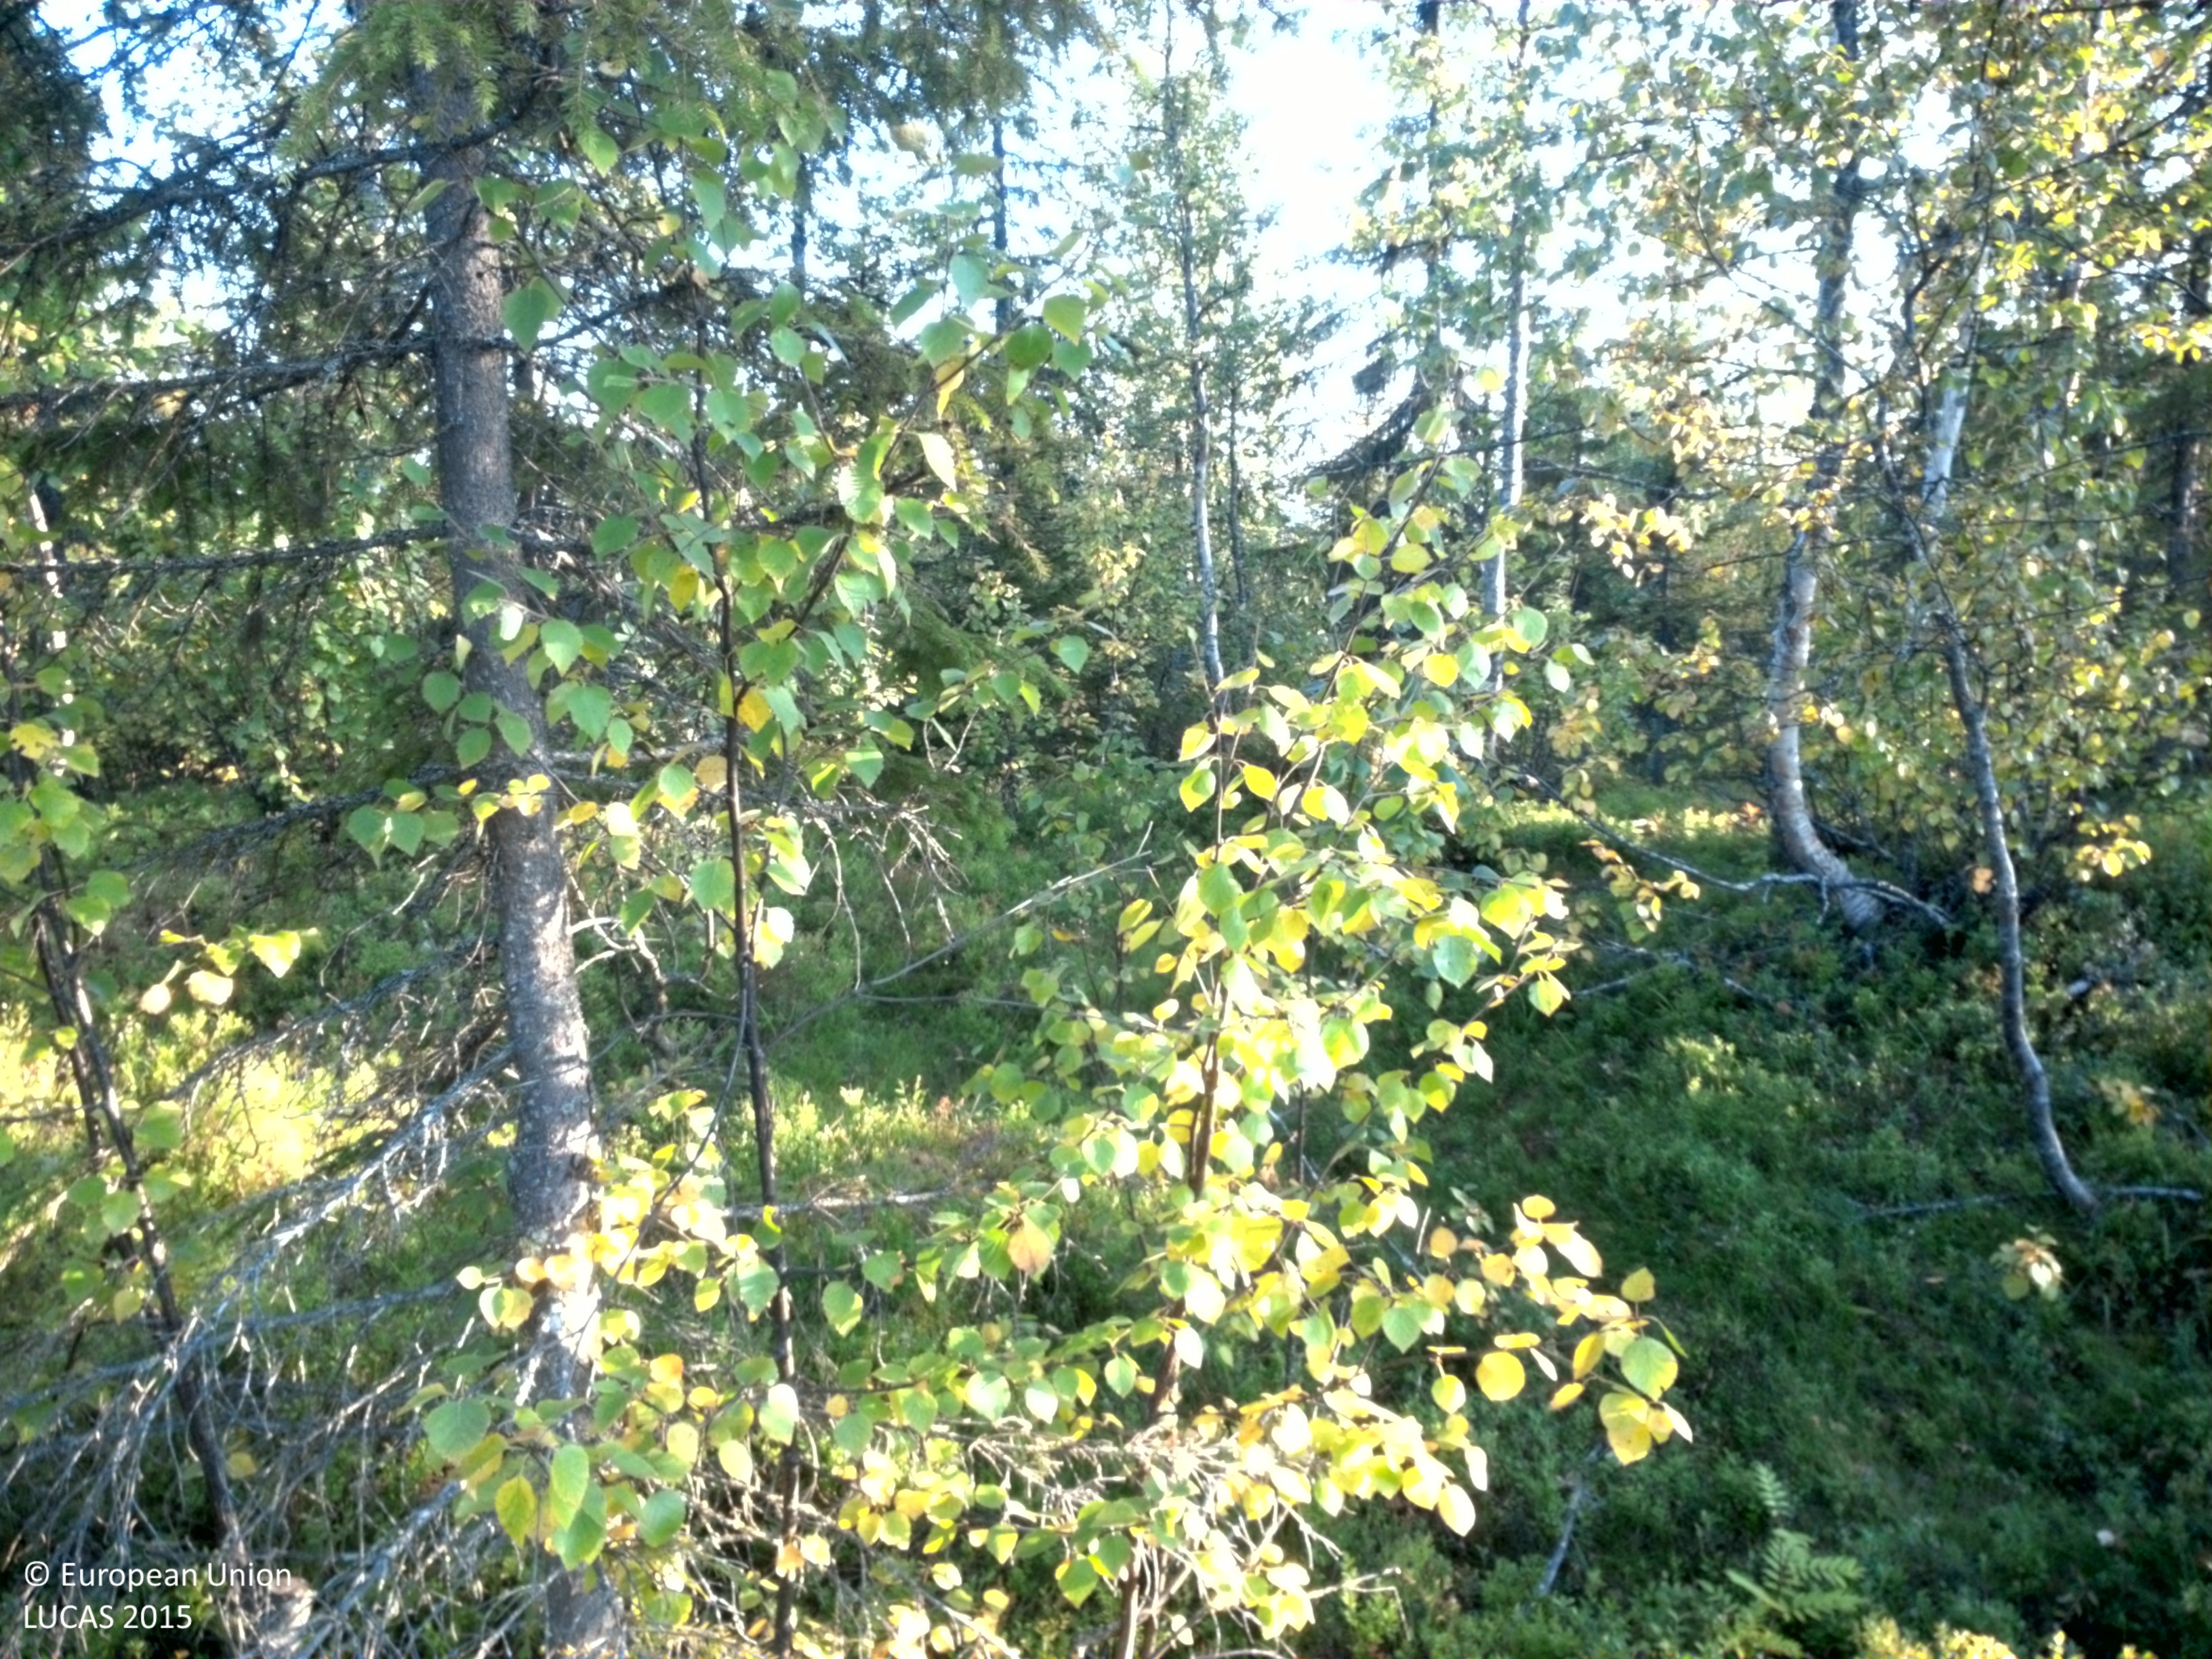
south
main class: Woodland
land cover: Spruce dominated mixed woodland
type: boreal forest
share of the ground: 25 - 50 %
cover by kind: shrubs 45 %, coniferous forest trees 15 %, broadleaved forest trees 15 %, herbaceous plants 15 %, lichens and mosses 10 %
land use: Forestry
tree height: > 5 m
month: September
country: SE
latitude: 65.3043
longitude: 16.8050
